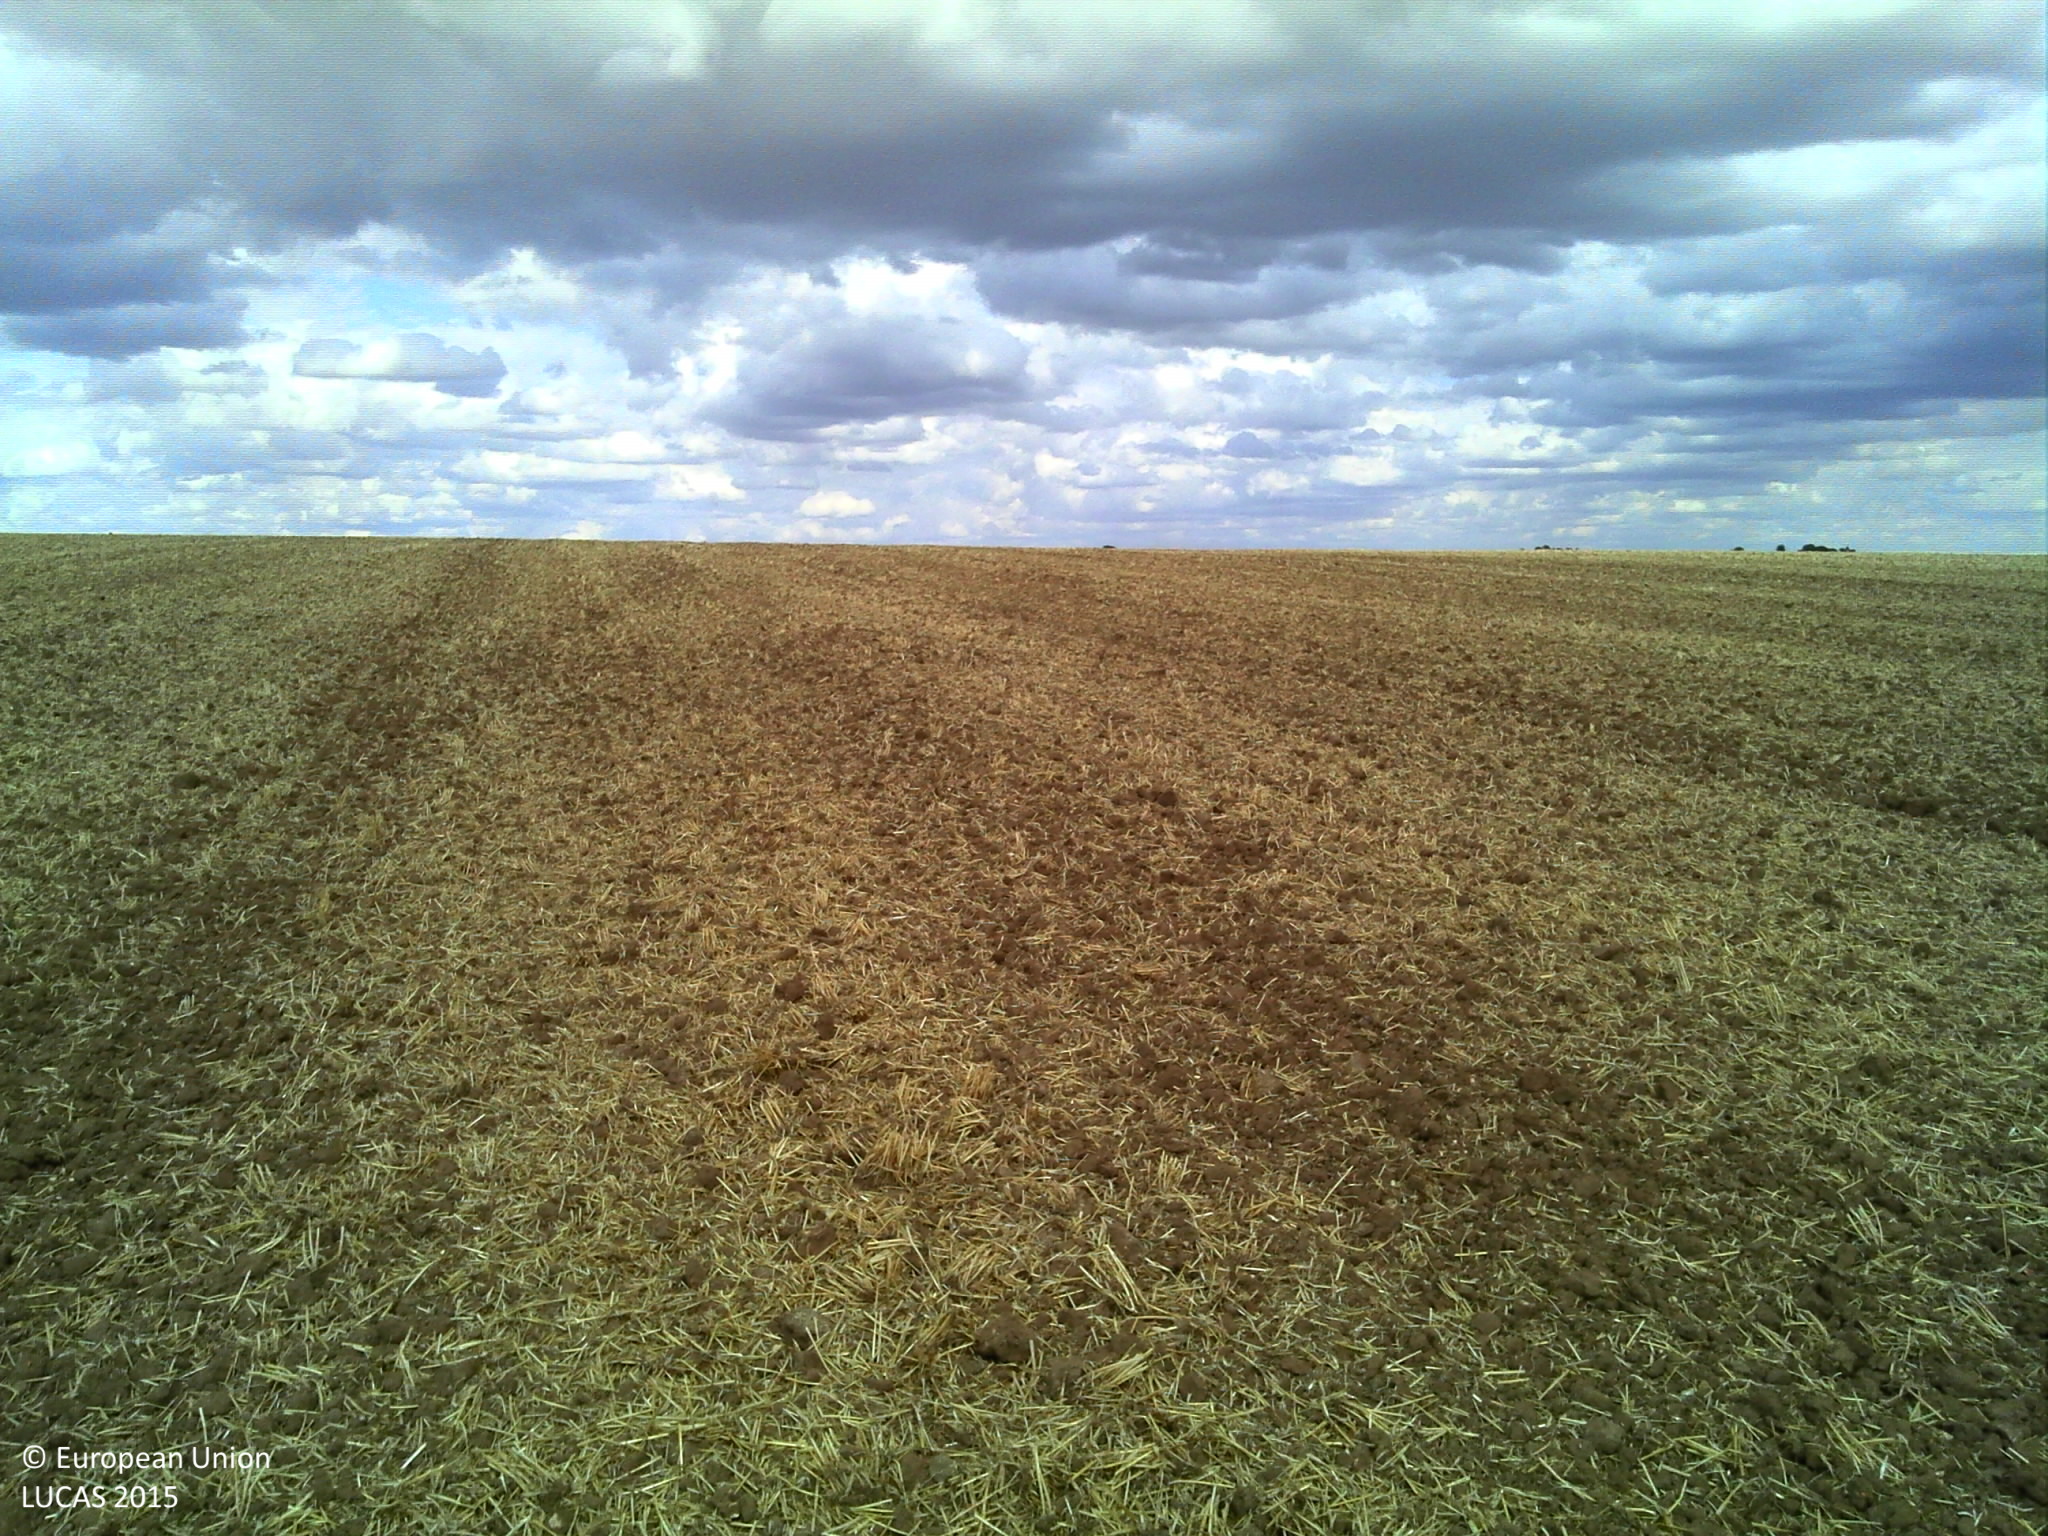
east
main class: Cropland
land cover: Common wheat
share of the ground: > 75 %
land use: Agriculture (excluding fallow land and kitchen gardens)
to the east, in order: Common wheat
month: July
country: FR
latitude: 47.9742
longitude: 3.4442
